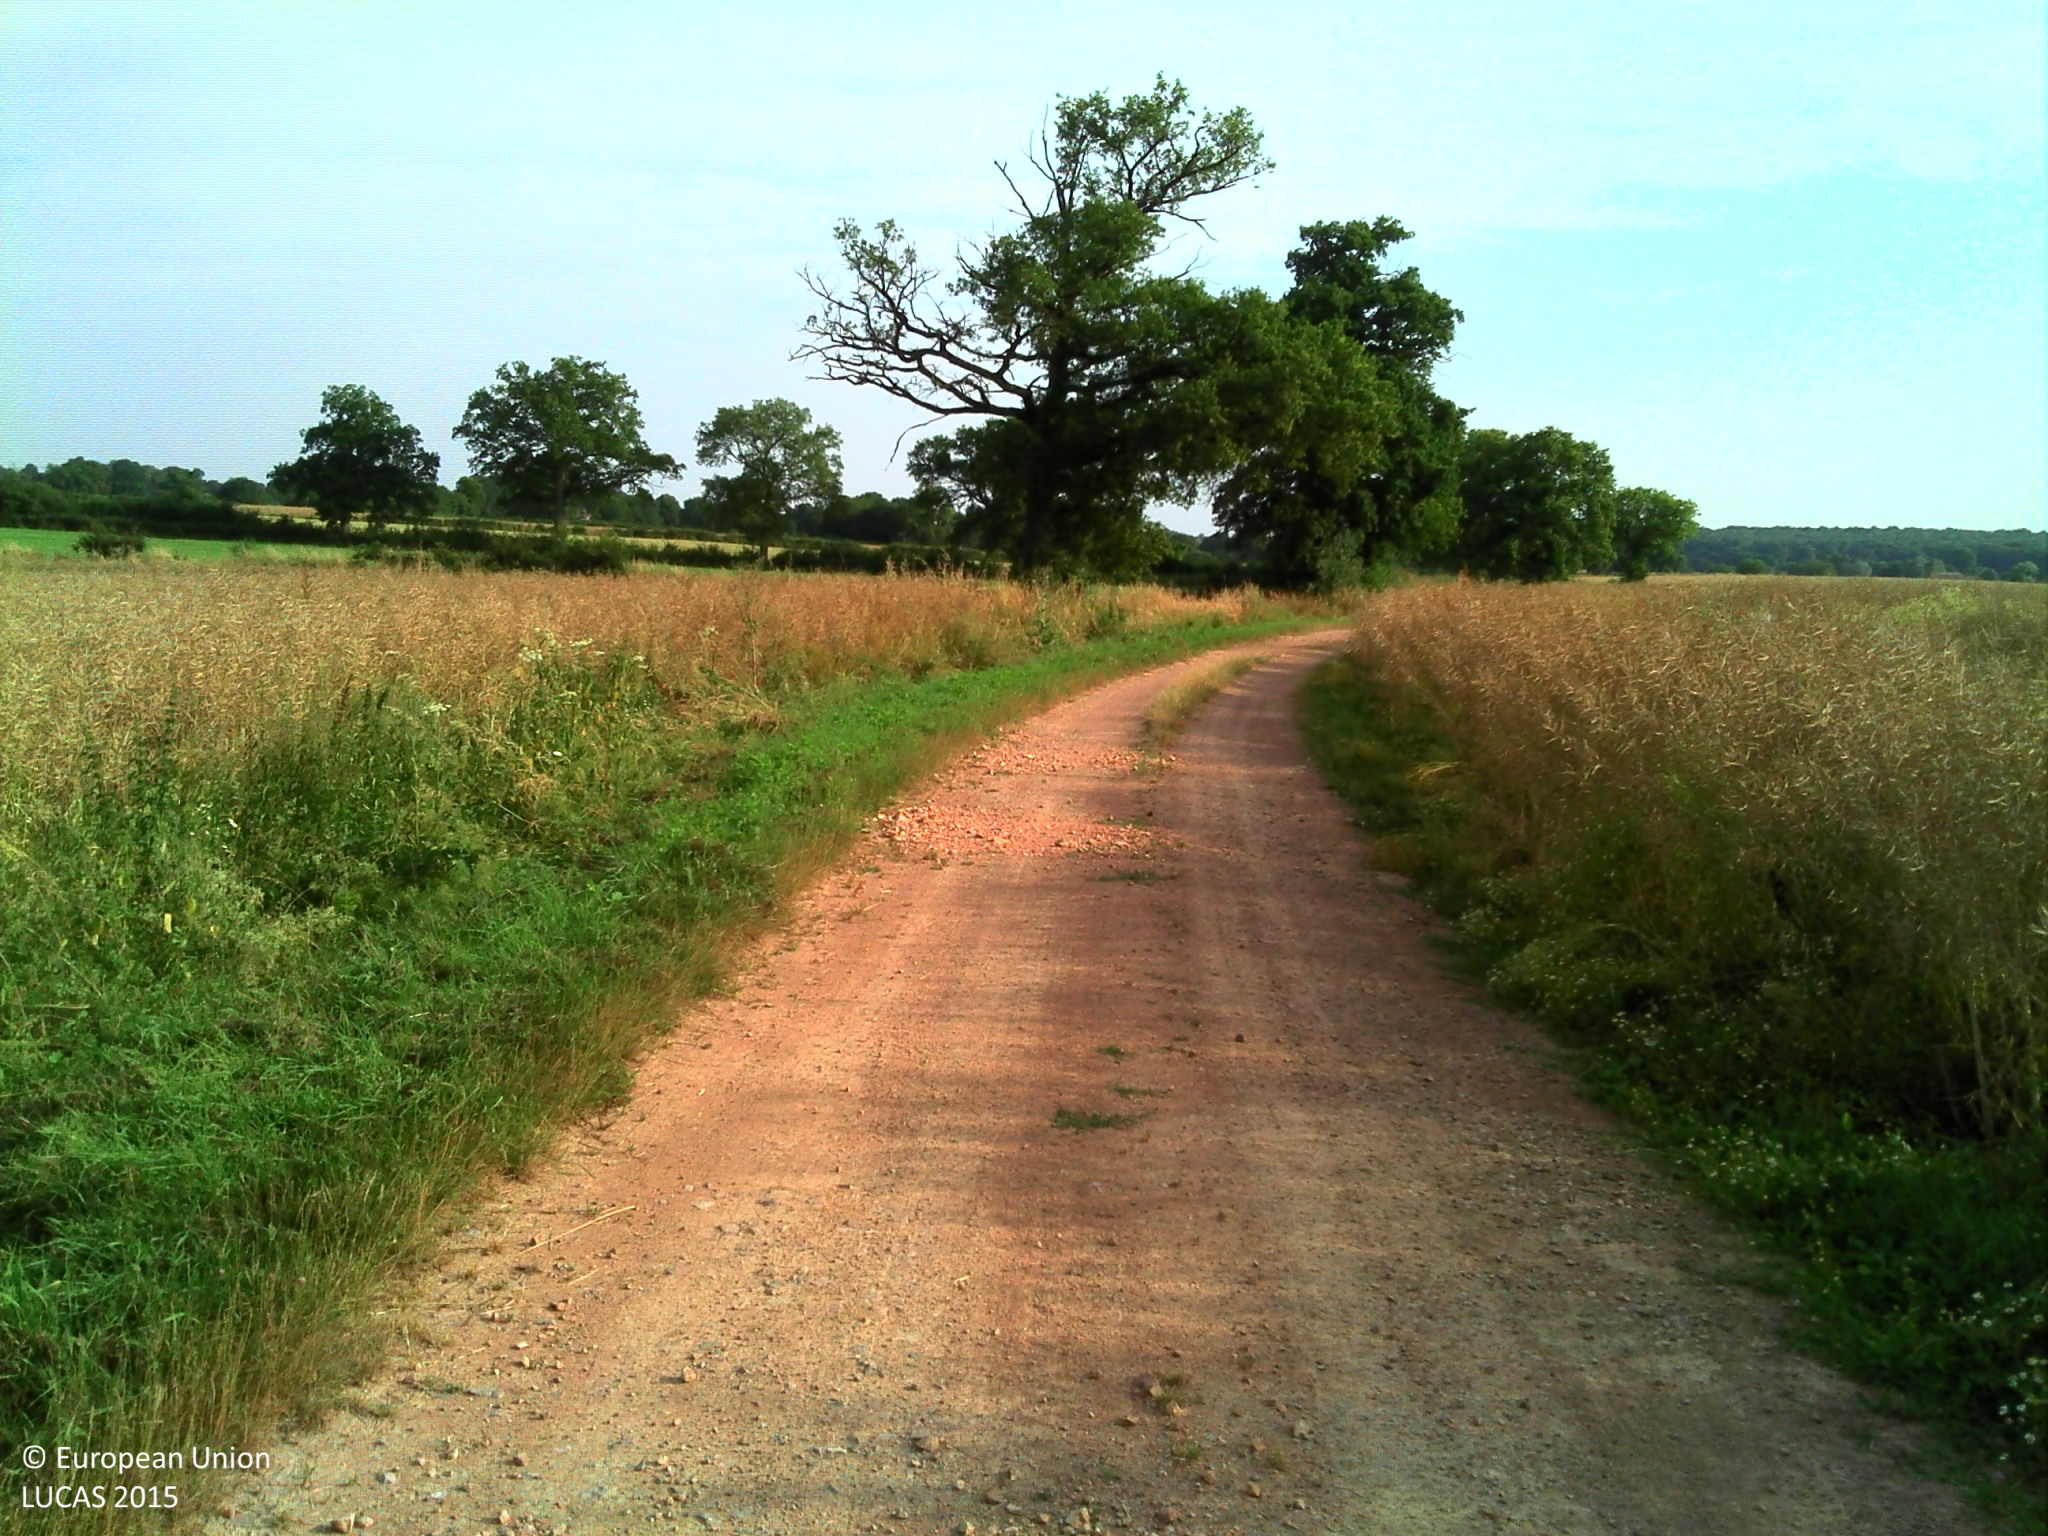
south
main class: Cropland
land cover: Rape and turnip rape
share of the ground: > 75 %
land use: Agriculture (excluding fallow land and kitchen gardens)
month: July
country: FR
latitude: 47.1514
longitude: 3.5746
